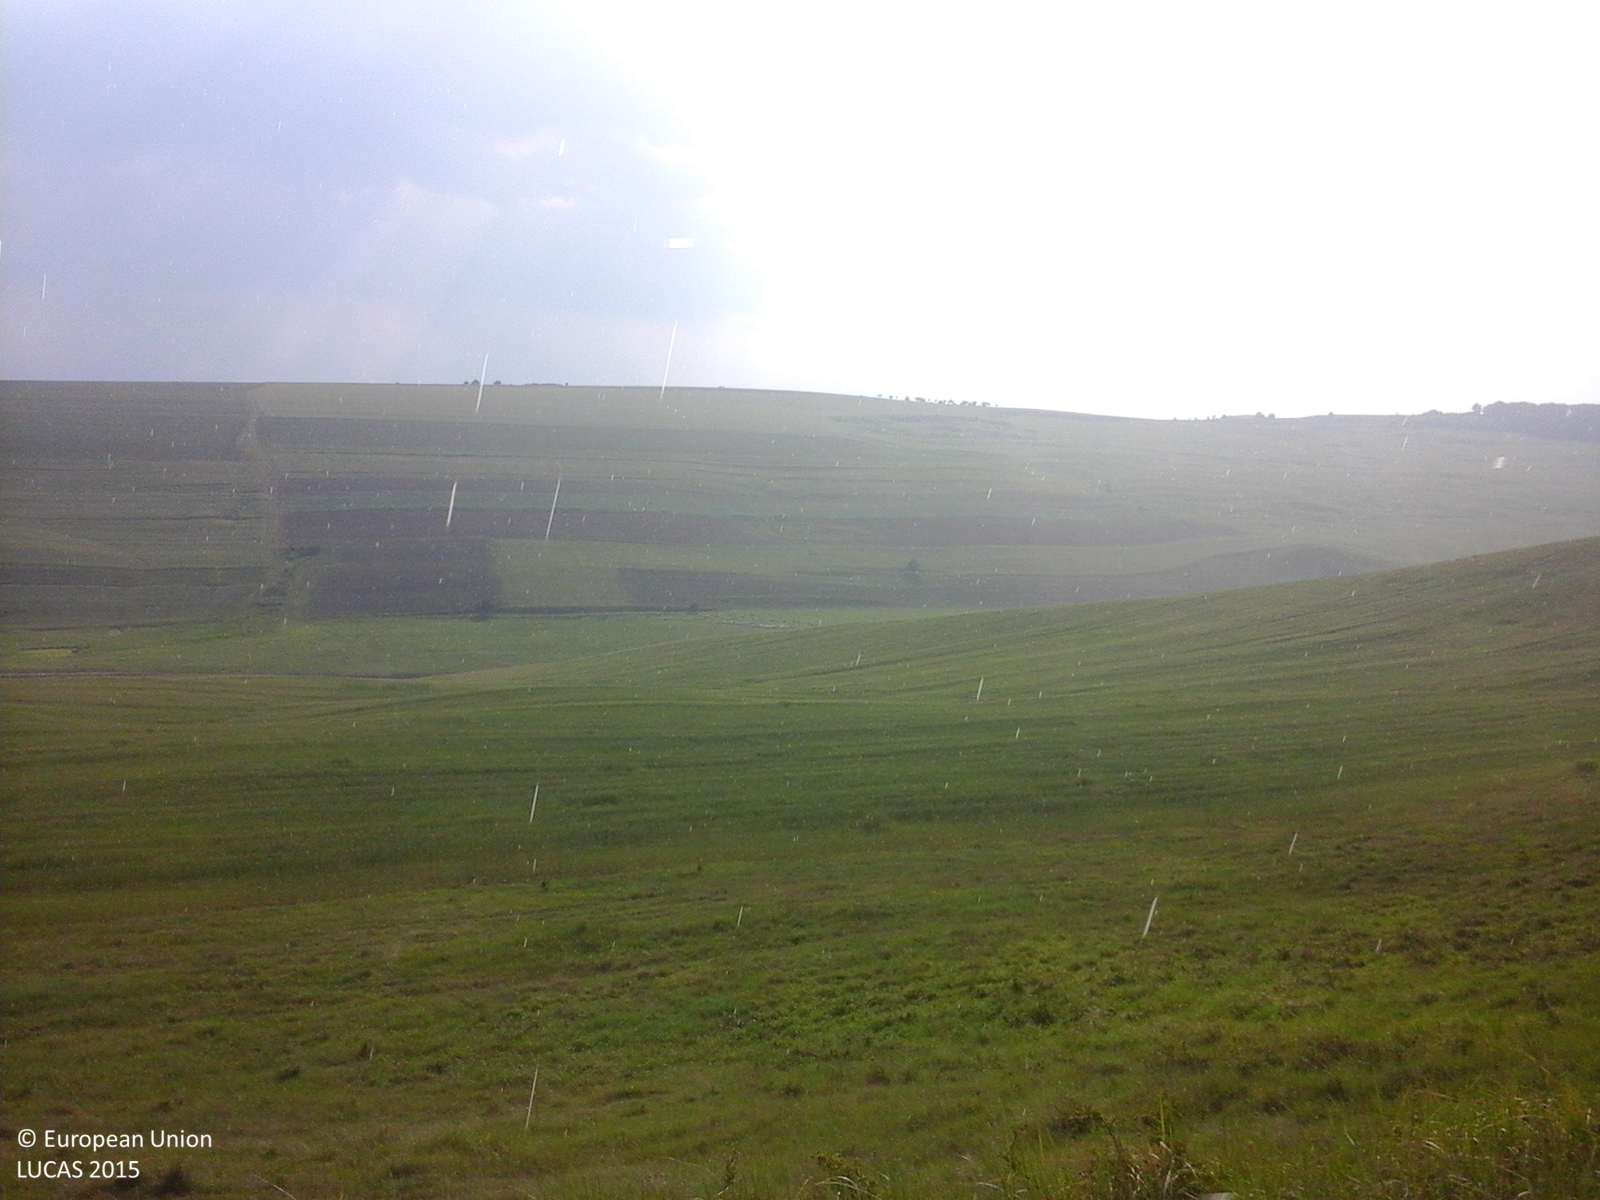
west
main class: Grassland
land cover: Grassland without tree/shrub cover
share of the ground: > 75 %
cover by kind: herbaceous plants 100 %
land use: Agriculture (excluding fallow land and kitchen gardens)
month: June
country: RO
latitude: 46.2885
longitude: 27.1946
